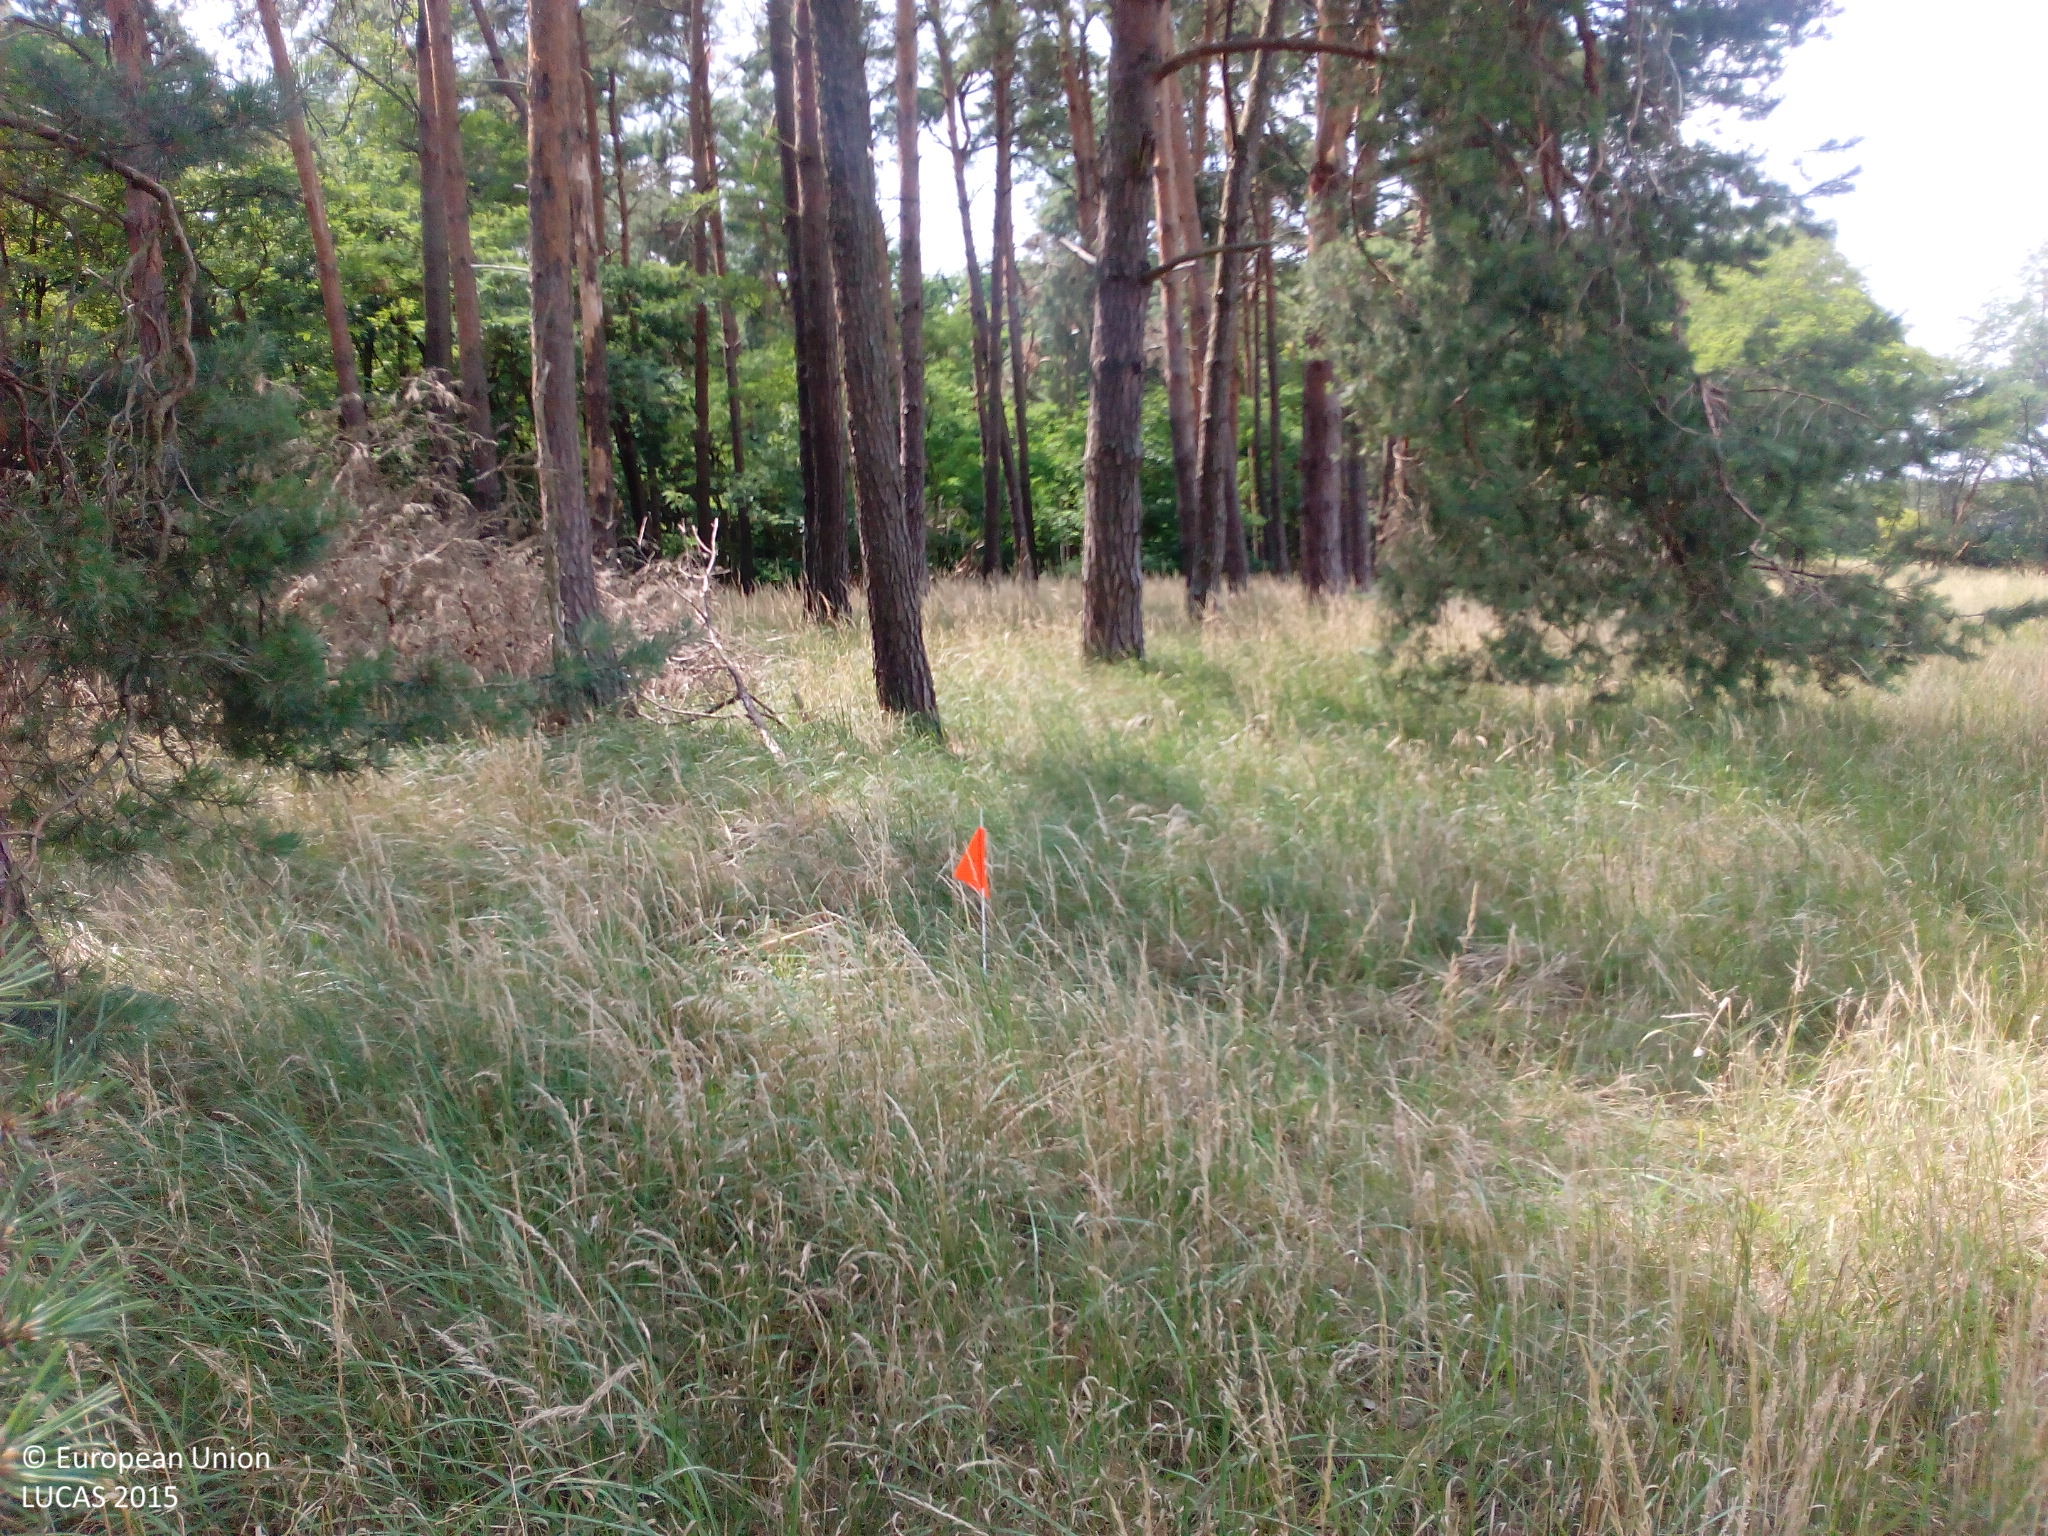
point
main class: Grassland
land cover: Grassland without tree/shrub cover
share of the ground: > 75 %
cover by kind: herbaceous plants 100 %
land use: Agriculture (excluding fallow land and kitchen gardens)
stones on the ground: < 10 %
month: July
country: DE
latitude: 51.8733
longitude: 12.1057
